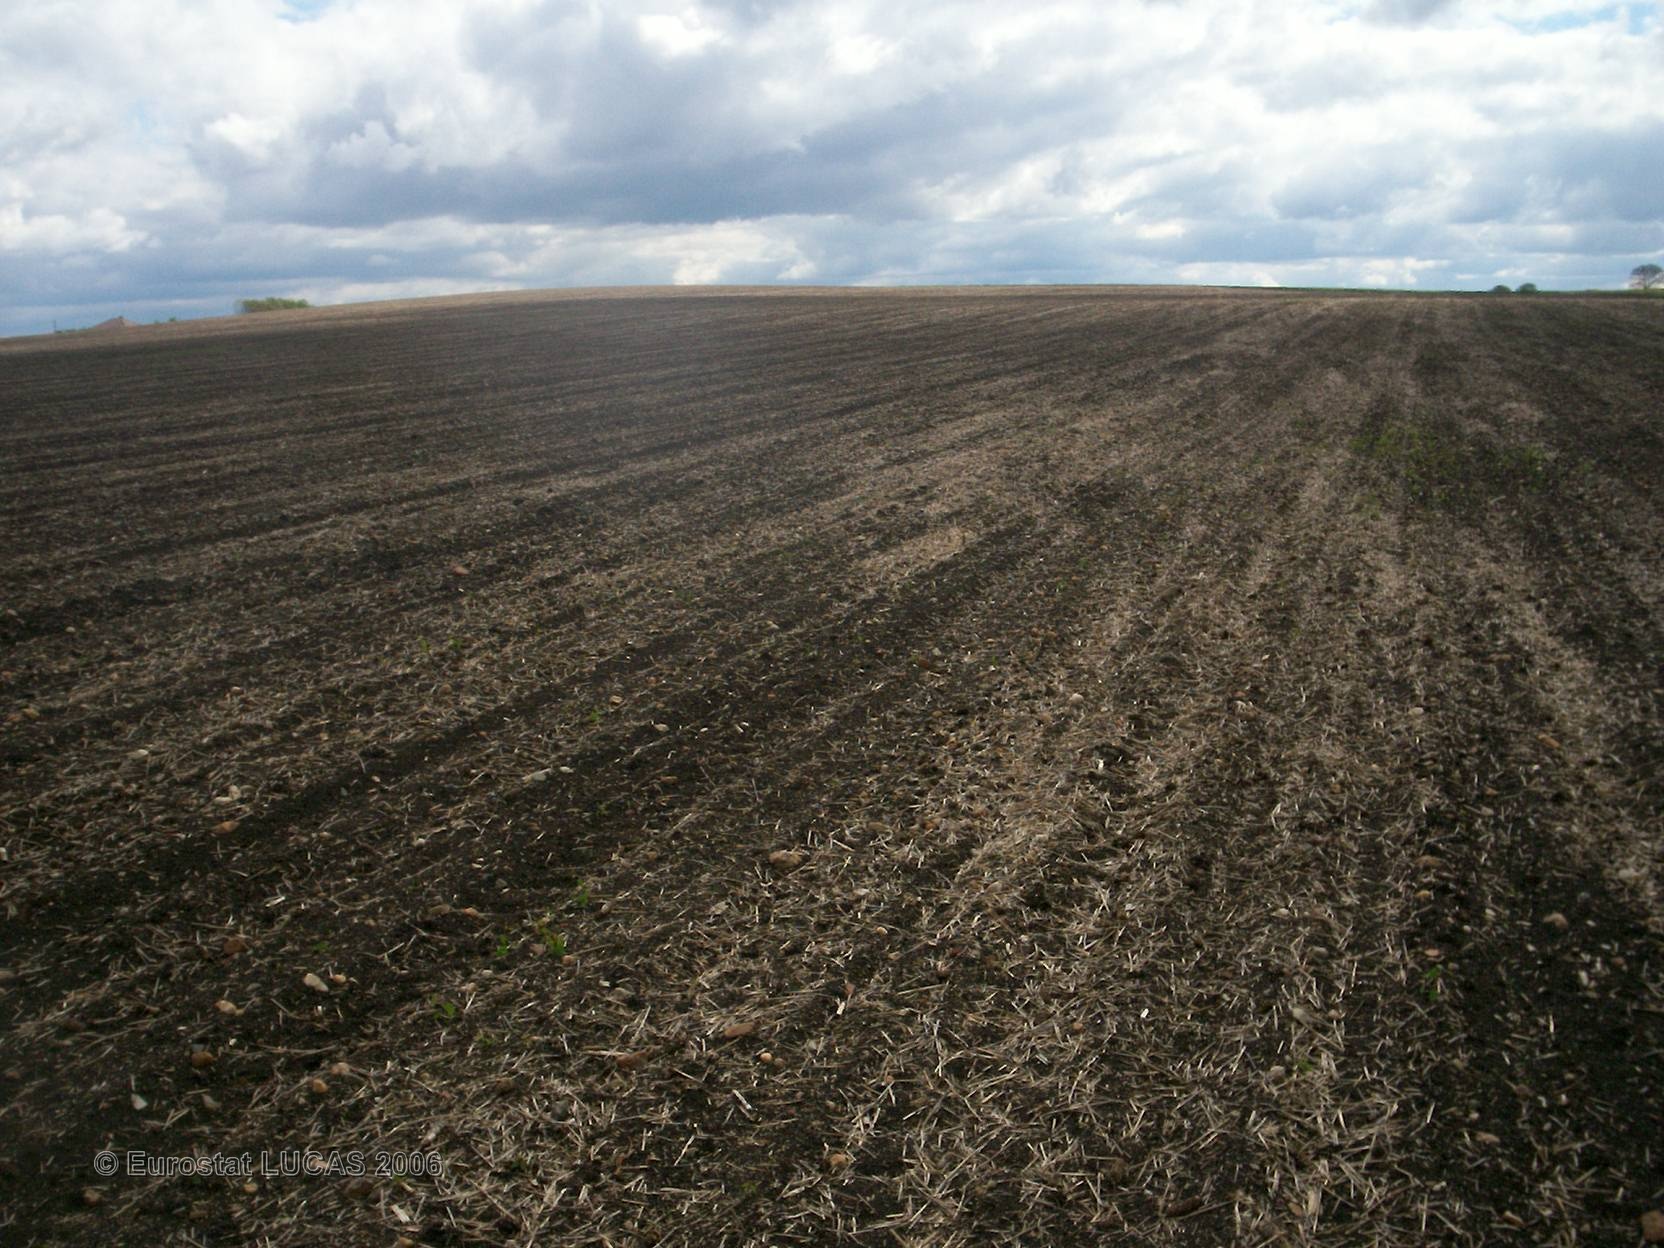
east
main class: Cropland
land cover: Maize
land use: Agriculture (excluding fallow land and kitchen gardens)
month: May
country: FR
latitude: 45.9344
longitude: 3.1769
